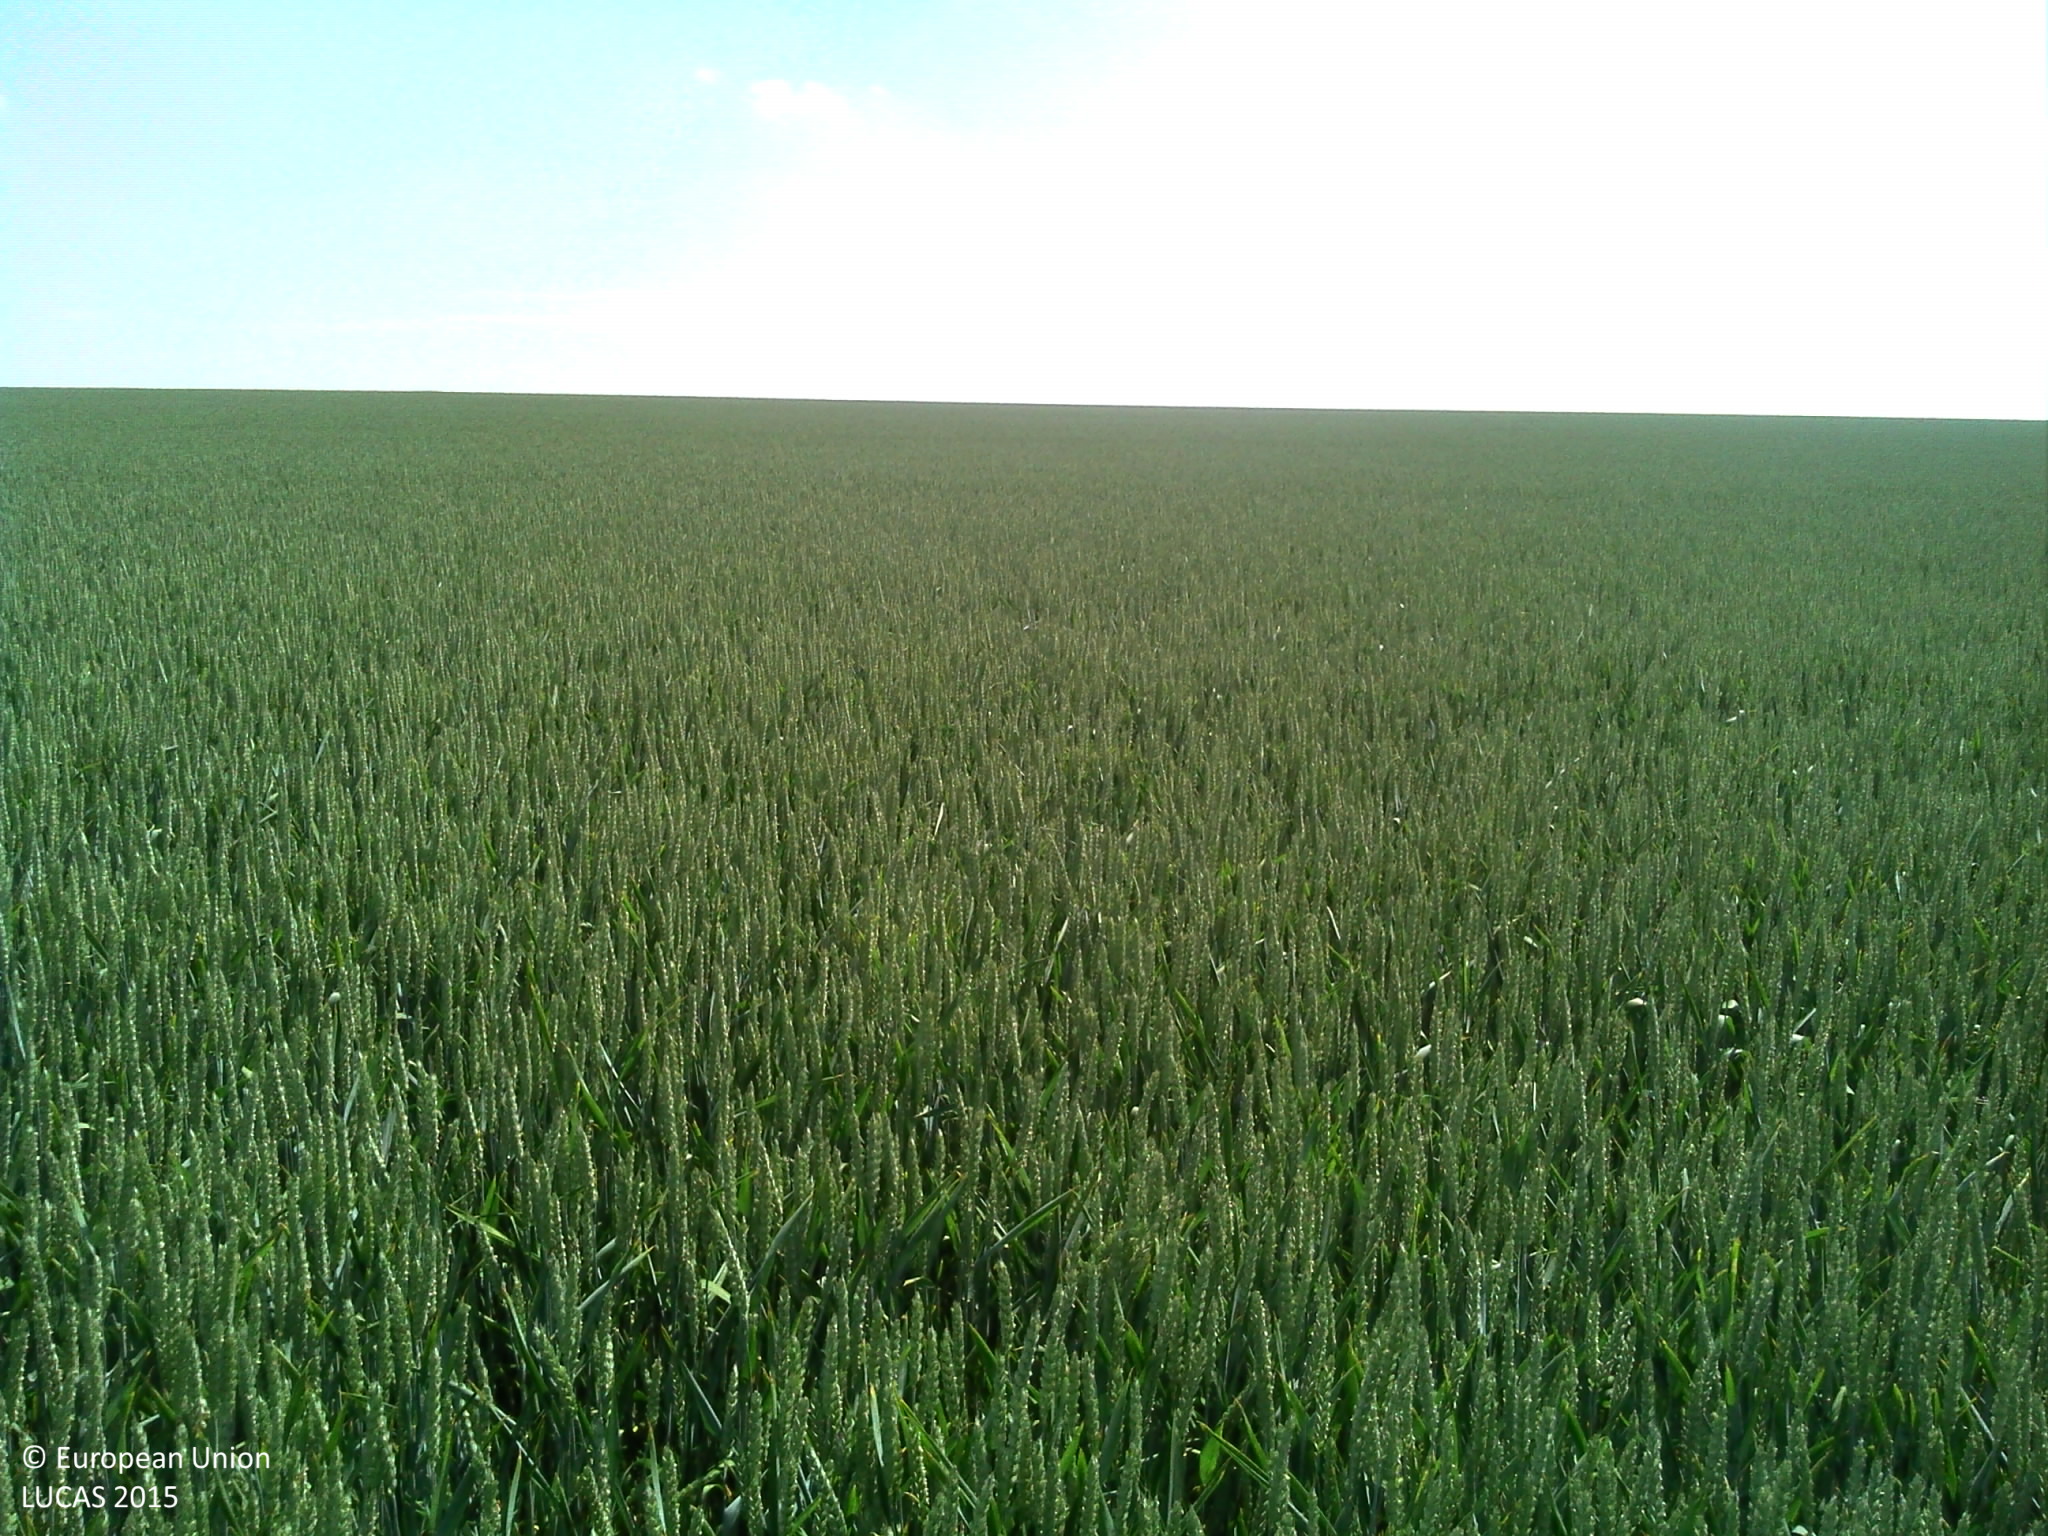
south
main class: Cropland
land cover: Common wheat
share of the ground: > 75 %
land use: Agriculture (excluding fallow land and kitchen gardens)
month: June
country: FR
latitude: 49.5235
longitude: 4.0407
